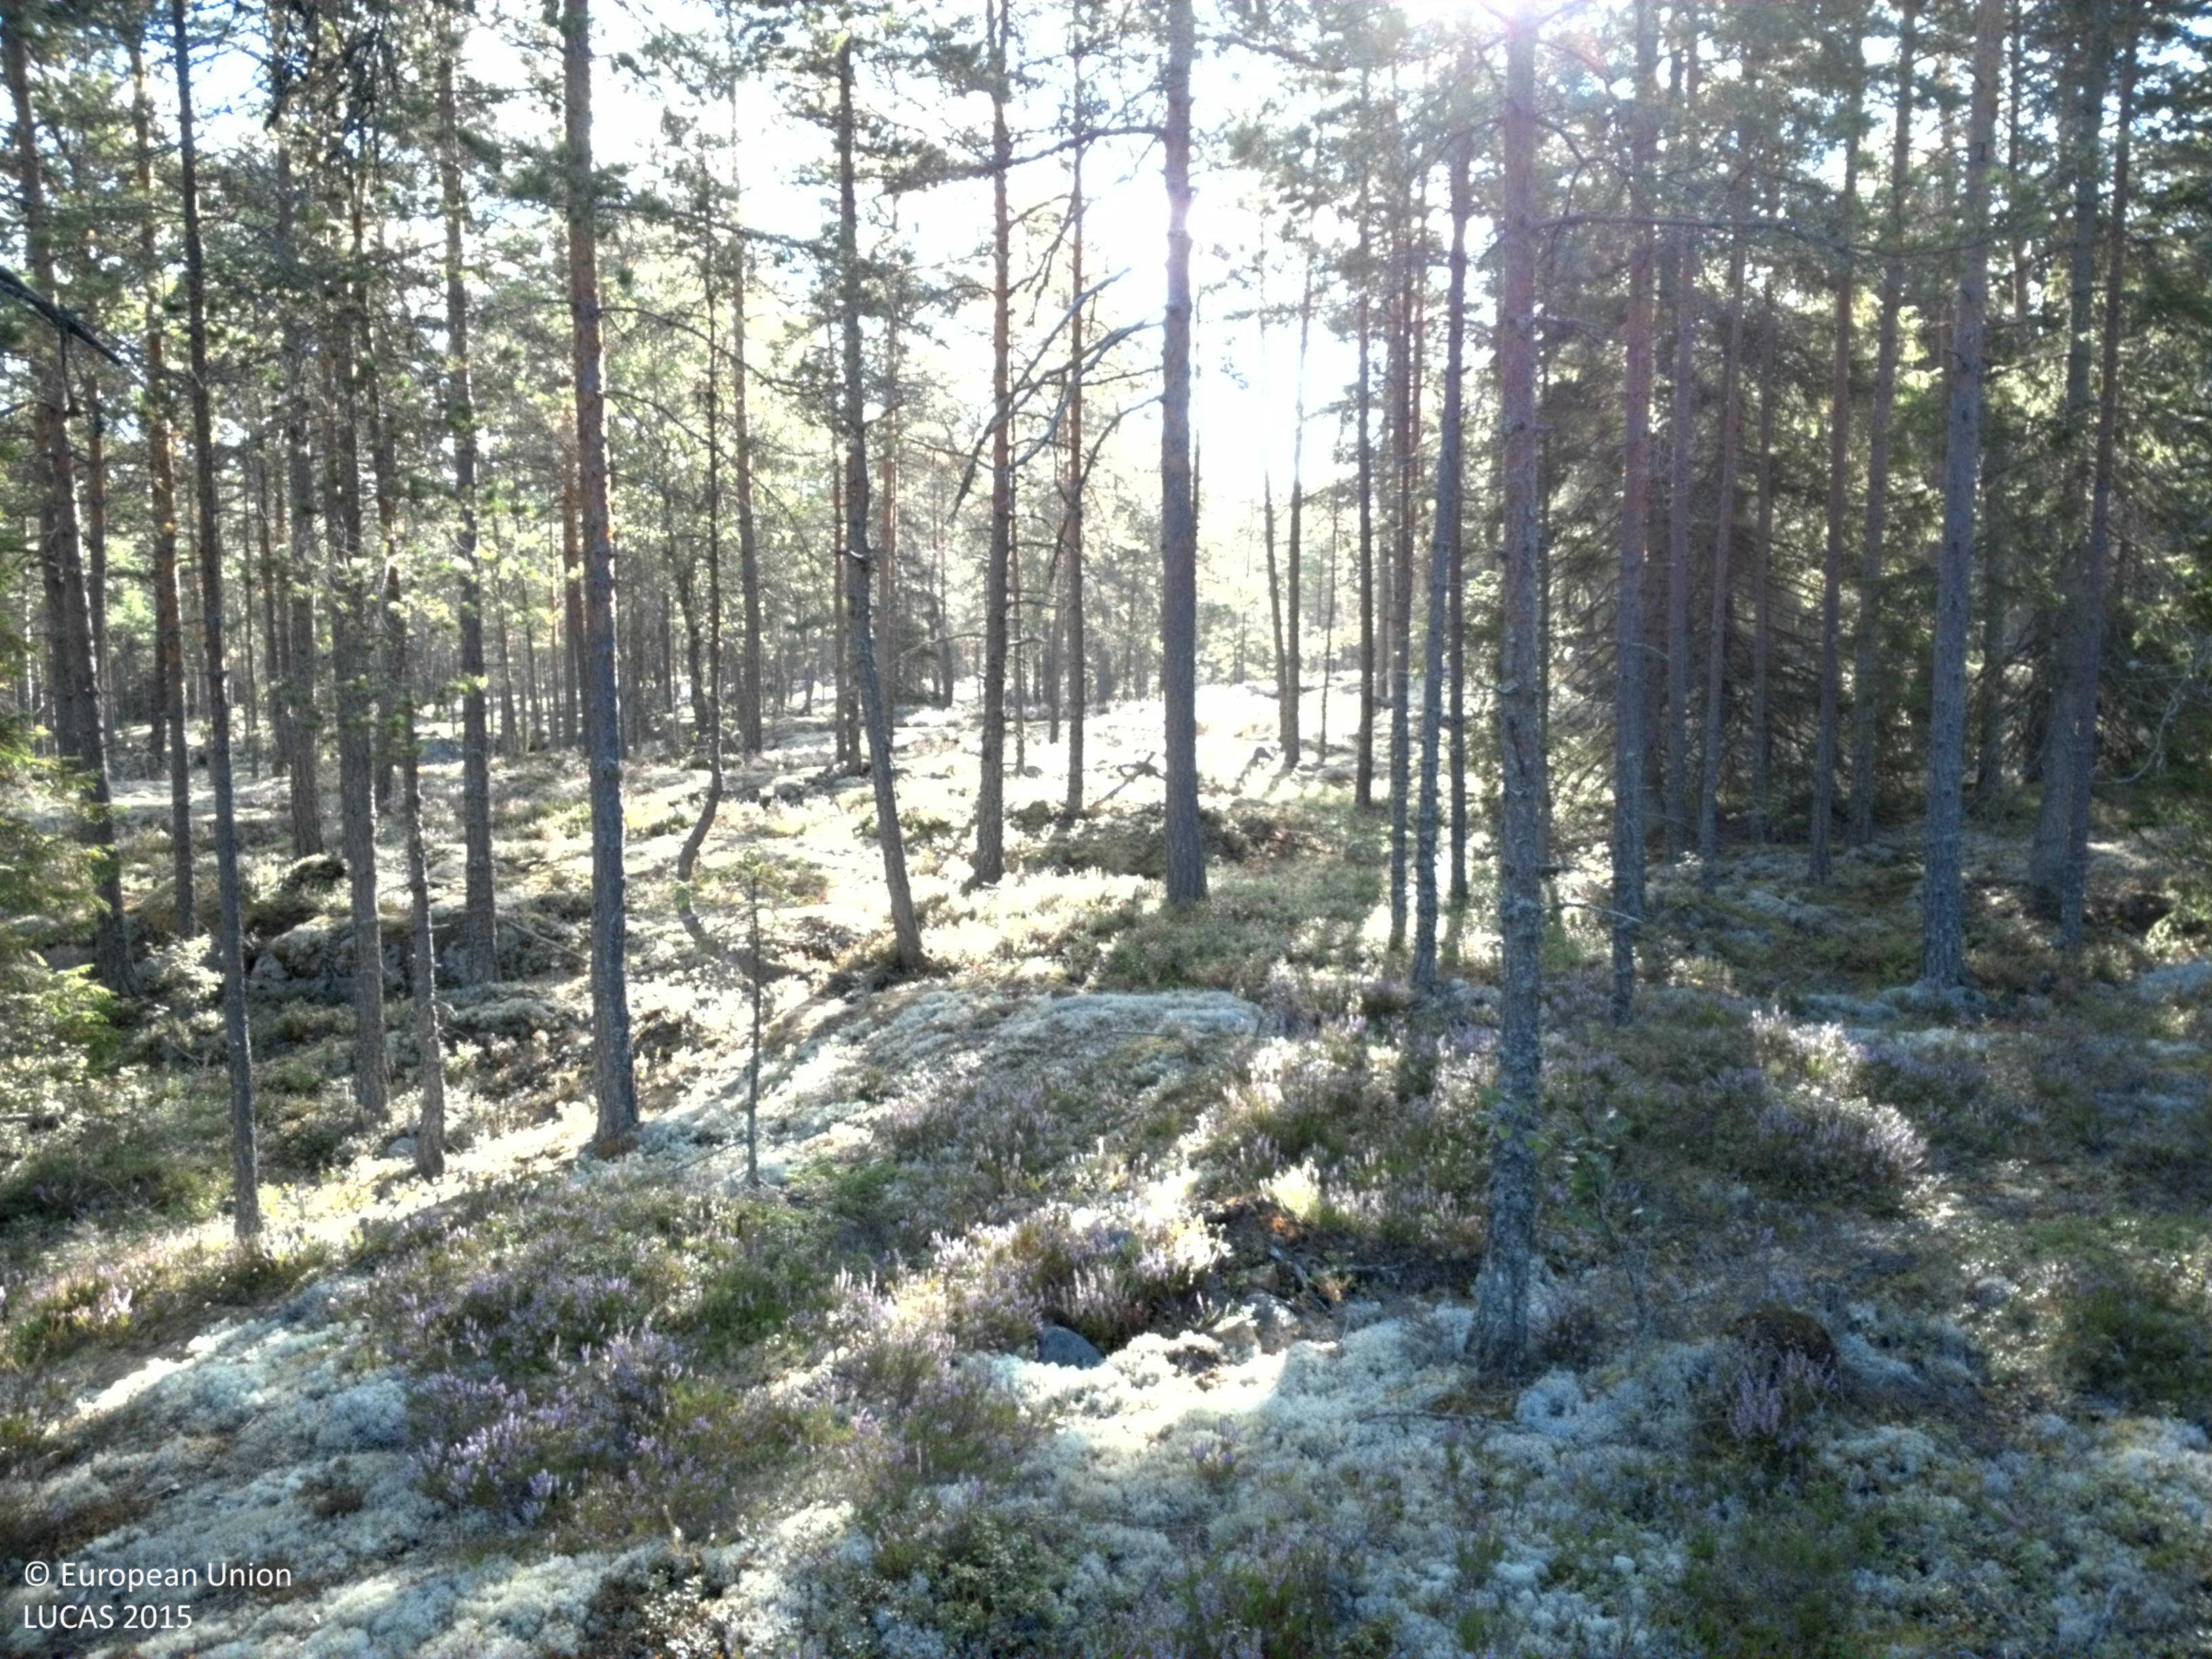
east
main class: Woodland
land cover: Pine dominated coniferous woodland
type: boreal forest
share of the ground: 25 - 50 %
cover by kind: coniferous forest trees 40 %, lichens and mosses 35 %, shrubs 25 %
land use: Forestry
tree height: > 5 m
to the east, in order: Pine dominated coniferous woodland; Other coniferous woodland; Pine dominated coniferous woodland; Pine dominated mixed woodland
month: August
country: SE
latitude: 59.8921
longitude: 17.1234
